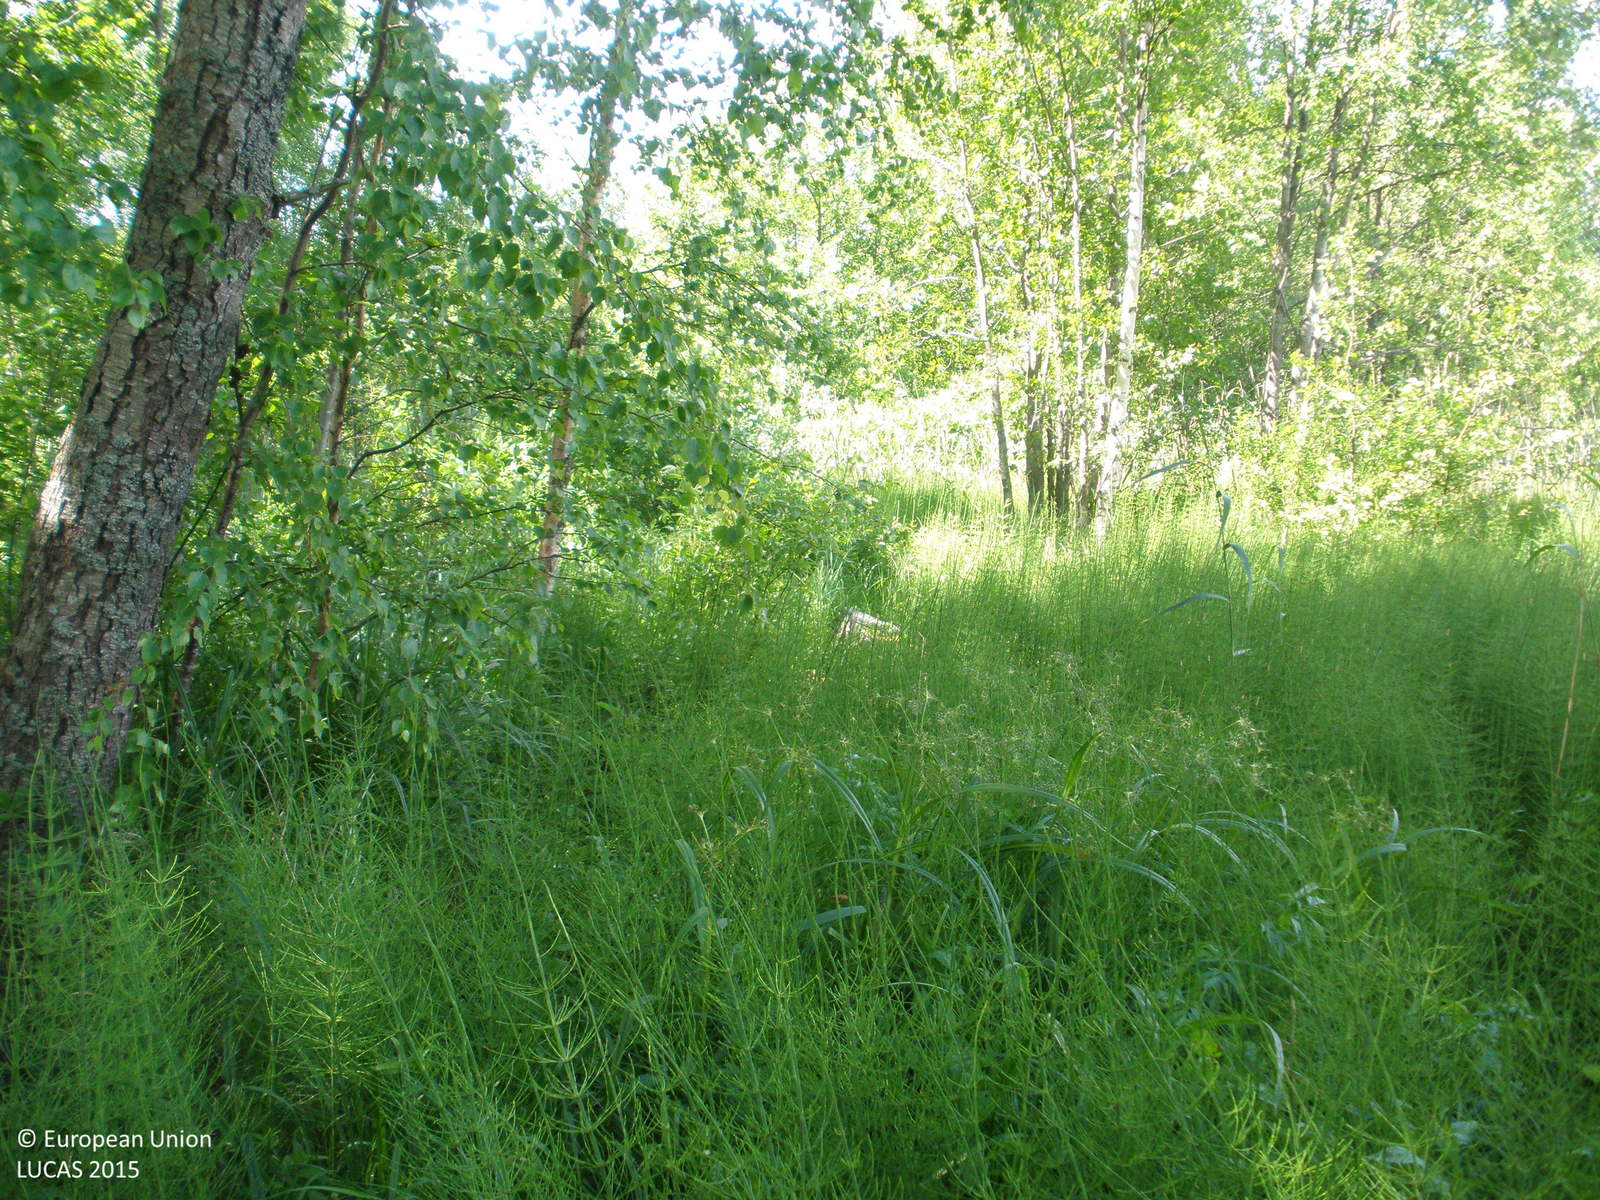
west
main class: Woodland
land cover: Broadleaved woodland
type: non-riverine alder, birch or aspen forest
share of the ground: > 75 %
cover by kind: broadleaved forest trees 80 %, herbaceous plants 20 %
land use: Forestry
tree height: > 5 m
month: June
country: FI
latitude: 61.0399
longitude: 24.1472
